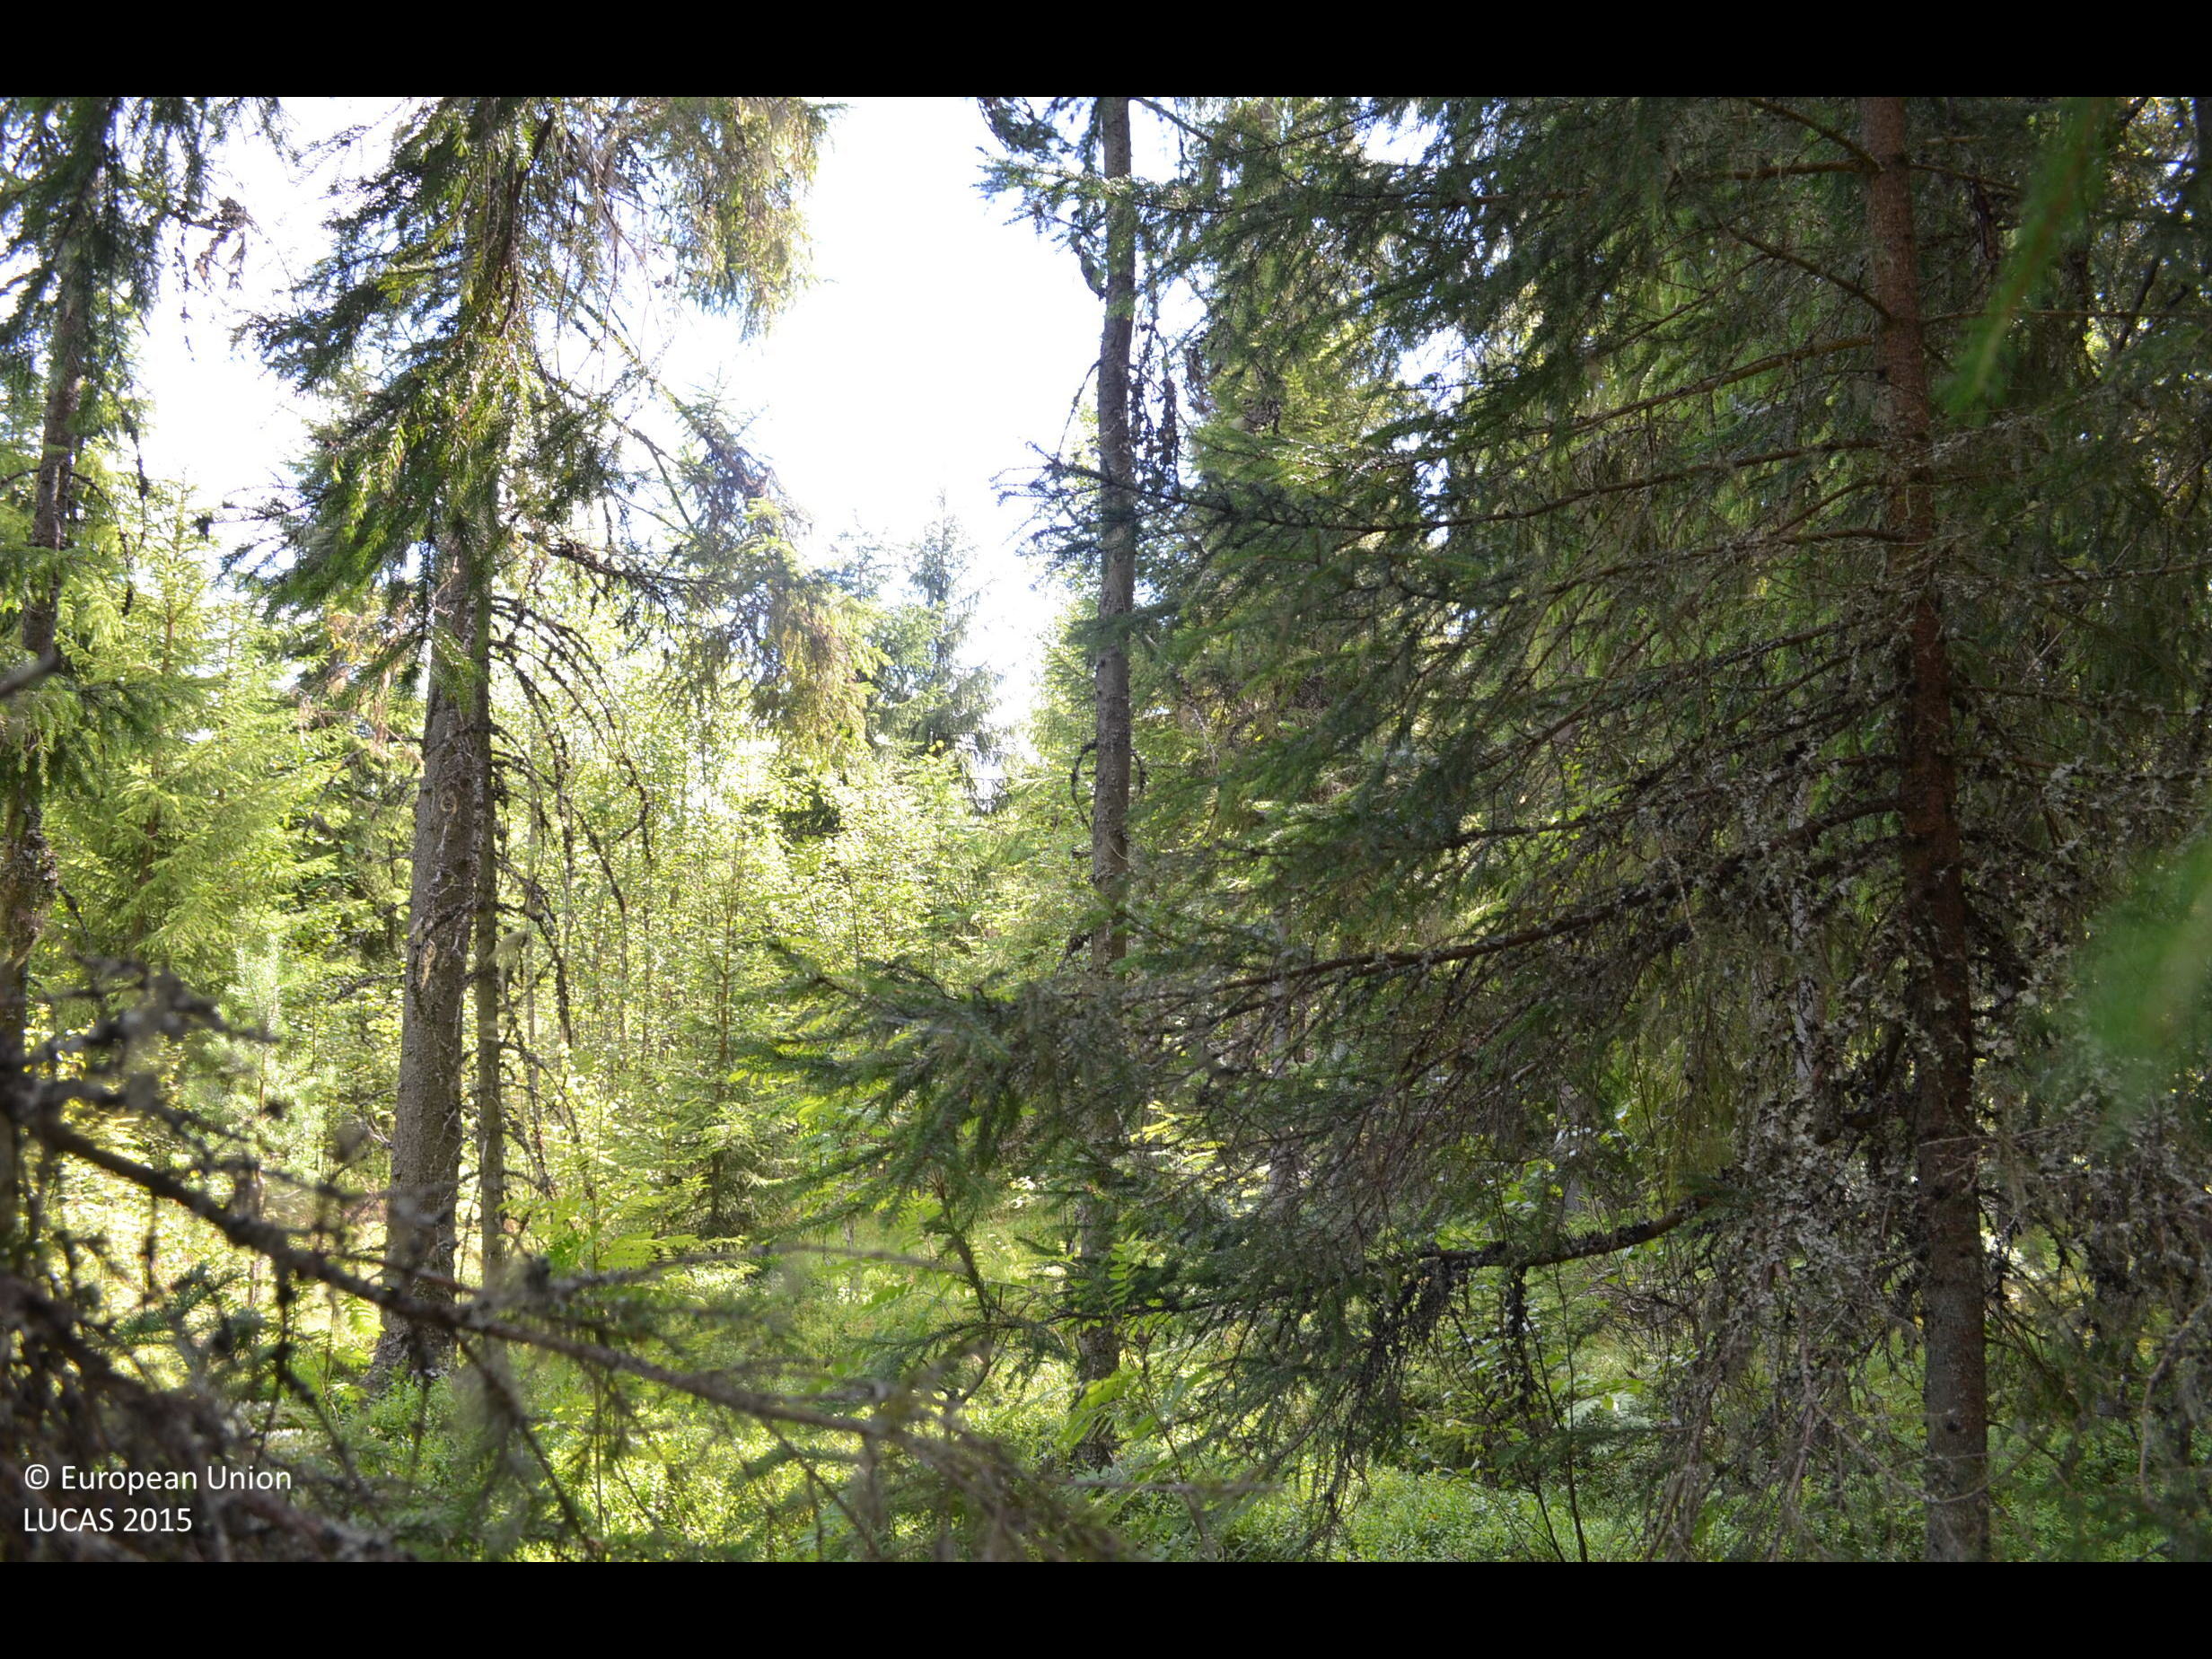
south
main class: Woodland
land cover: Spruce dominated coniferous woodland
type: boreal forest
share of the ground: > 75 %
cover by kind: coniferous forest trees 75 %, broadleaved forest trees 10 %, shrubs 10 %, lichens and mosses 5 %
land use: Forestry
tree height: > 5 m
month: August
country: FI
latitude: 61.6398
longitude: 23.0352
